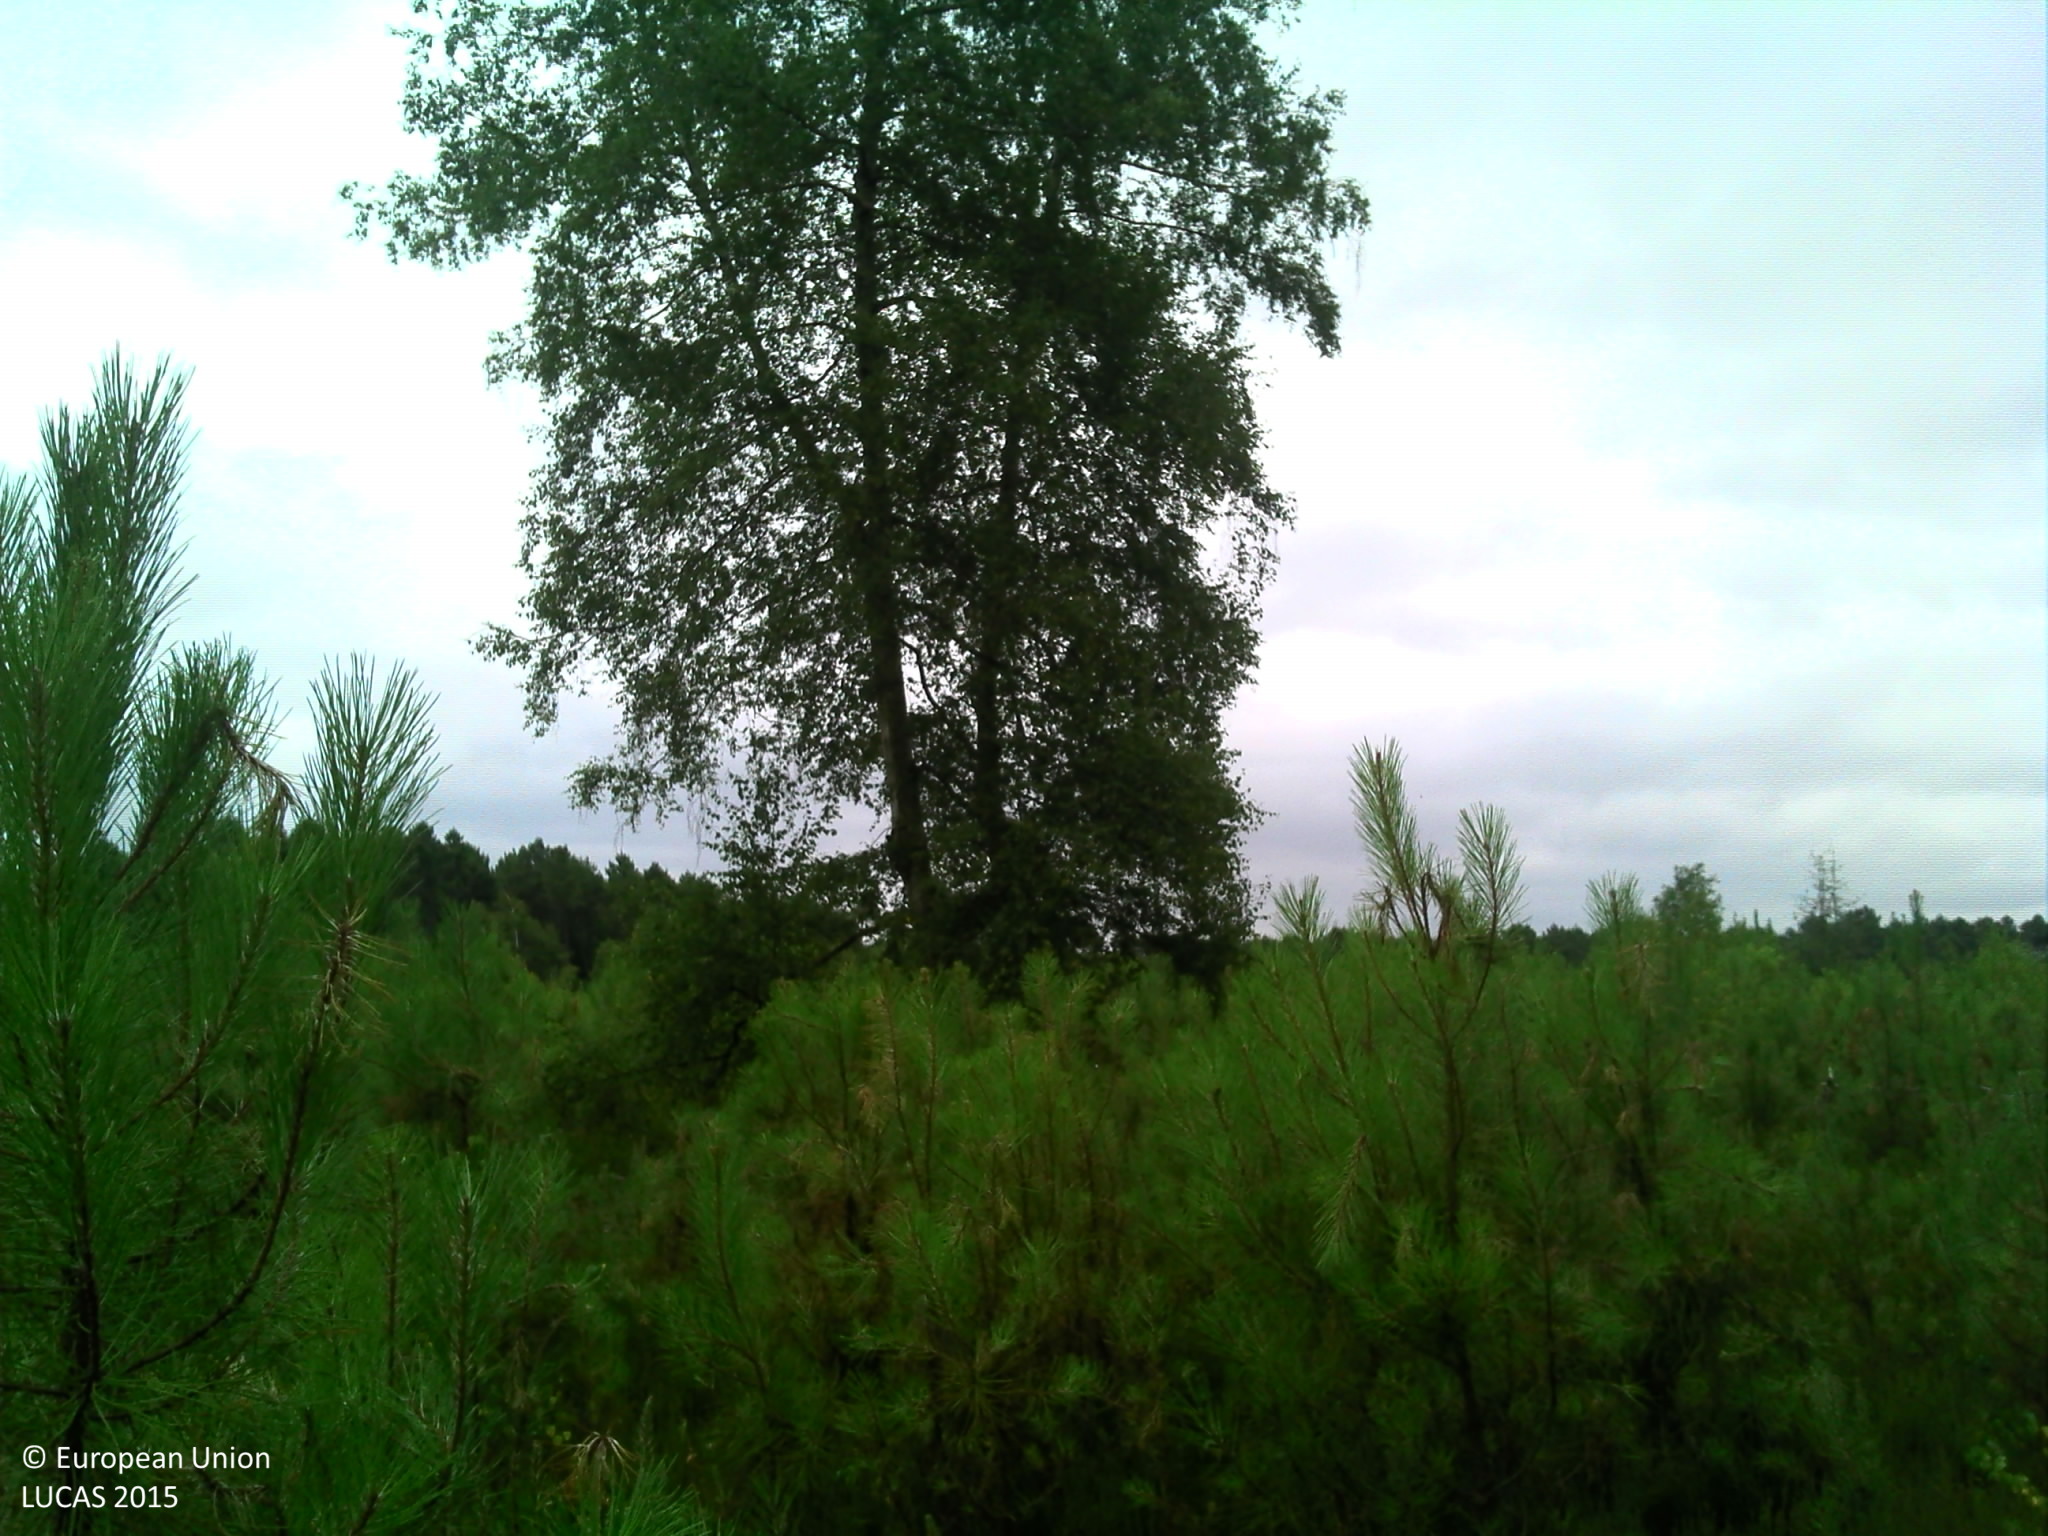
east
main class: Woodland
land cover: Pine dominated coniferous woodland
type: exotic forest
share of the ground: 50 - 75 %
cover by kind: coniferous forest trees 50 %, herbaceous plants 30 %, shrubs 20 %
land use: Forestry
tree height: < 5 m
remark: Nursery
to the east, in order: Pine dominated coniferous woodland; Tracks; Pine dominated coniferous woodland
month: July
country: FR
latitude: 47.8776
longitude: 0.4161
